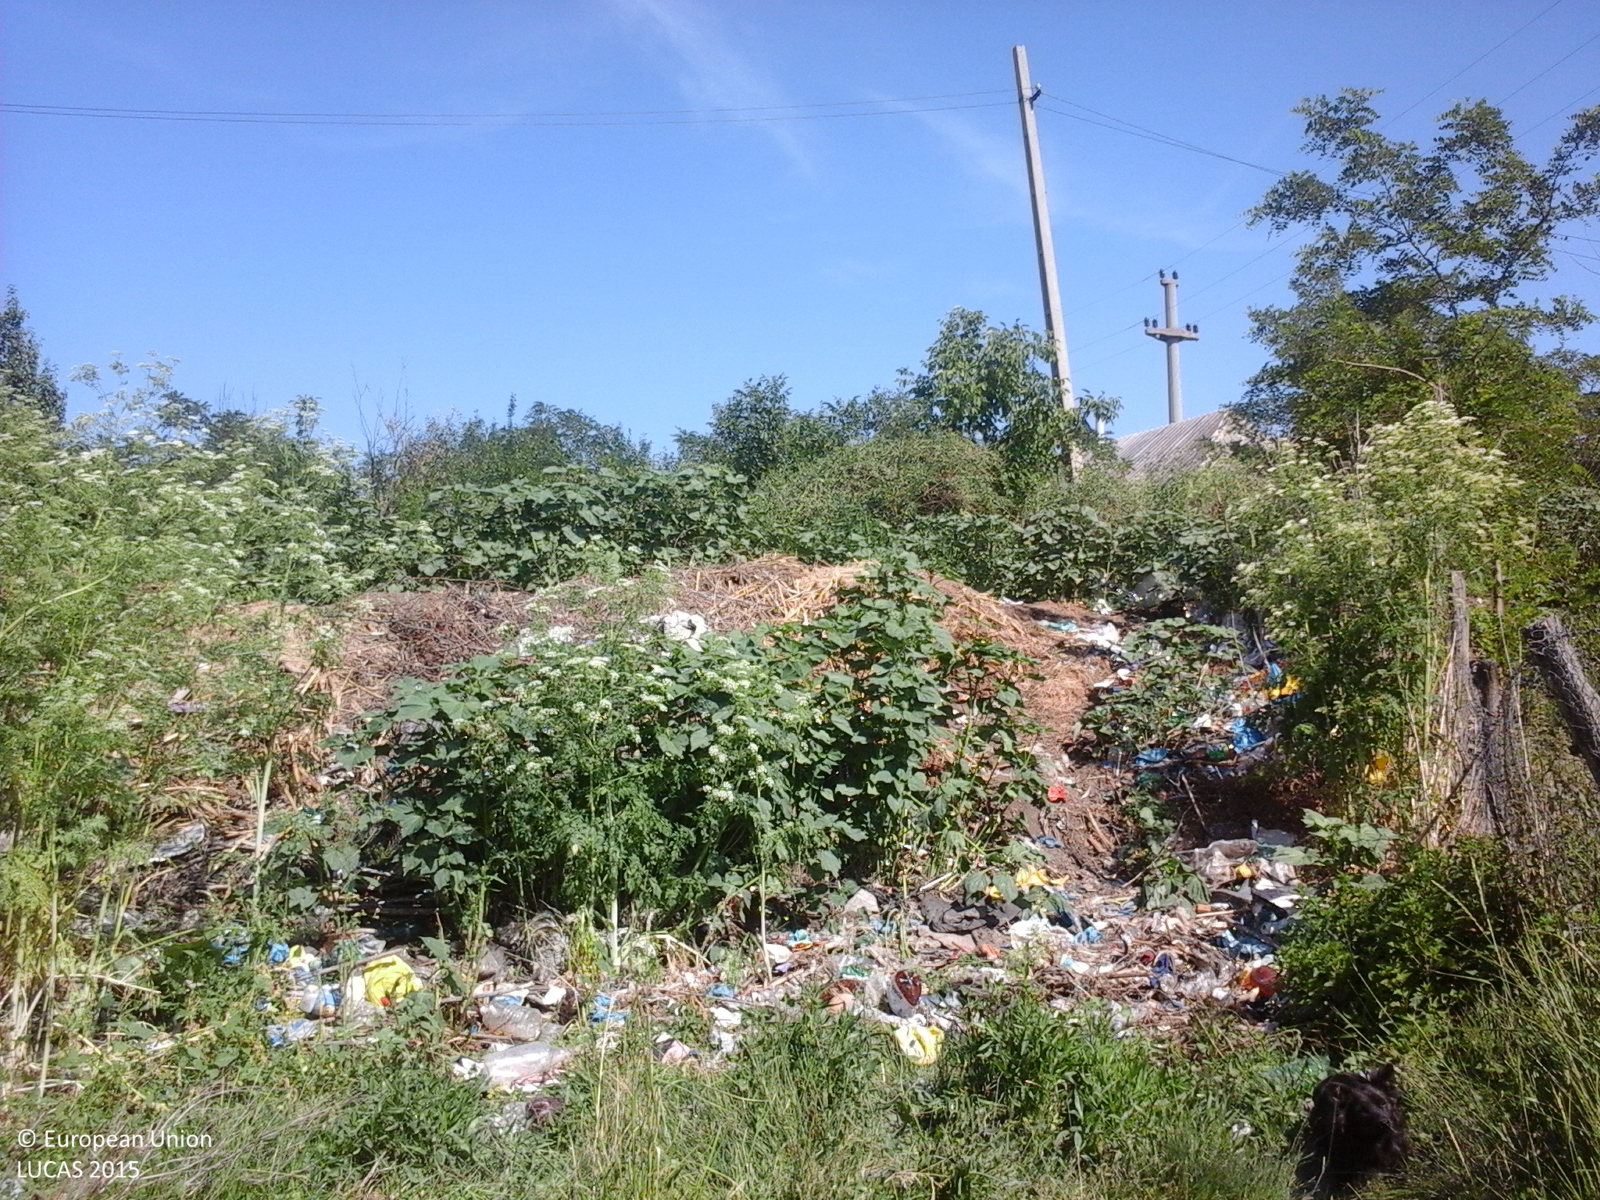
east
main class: Grassland
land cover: Spontaneously vegetated surfaces
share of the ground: > 75 %
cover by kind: herbaceous plants 100 %
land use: Agriculture (excluding fallow land and kitchen gardens)
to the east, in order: Spontaneously vegetated surfaces; Fences; Spontaneously vegetated surfaces; Artificial constructions in urban areas; Permanent crops (only in case pi); Fences; Arable land (only in case pi); Artificial constructions in urban areas; Other fruit trees and berries
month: June
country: RO
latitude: 47.2841
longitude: 27.0664
